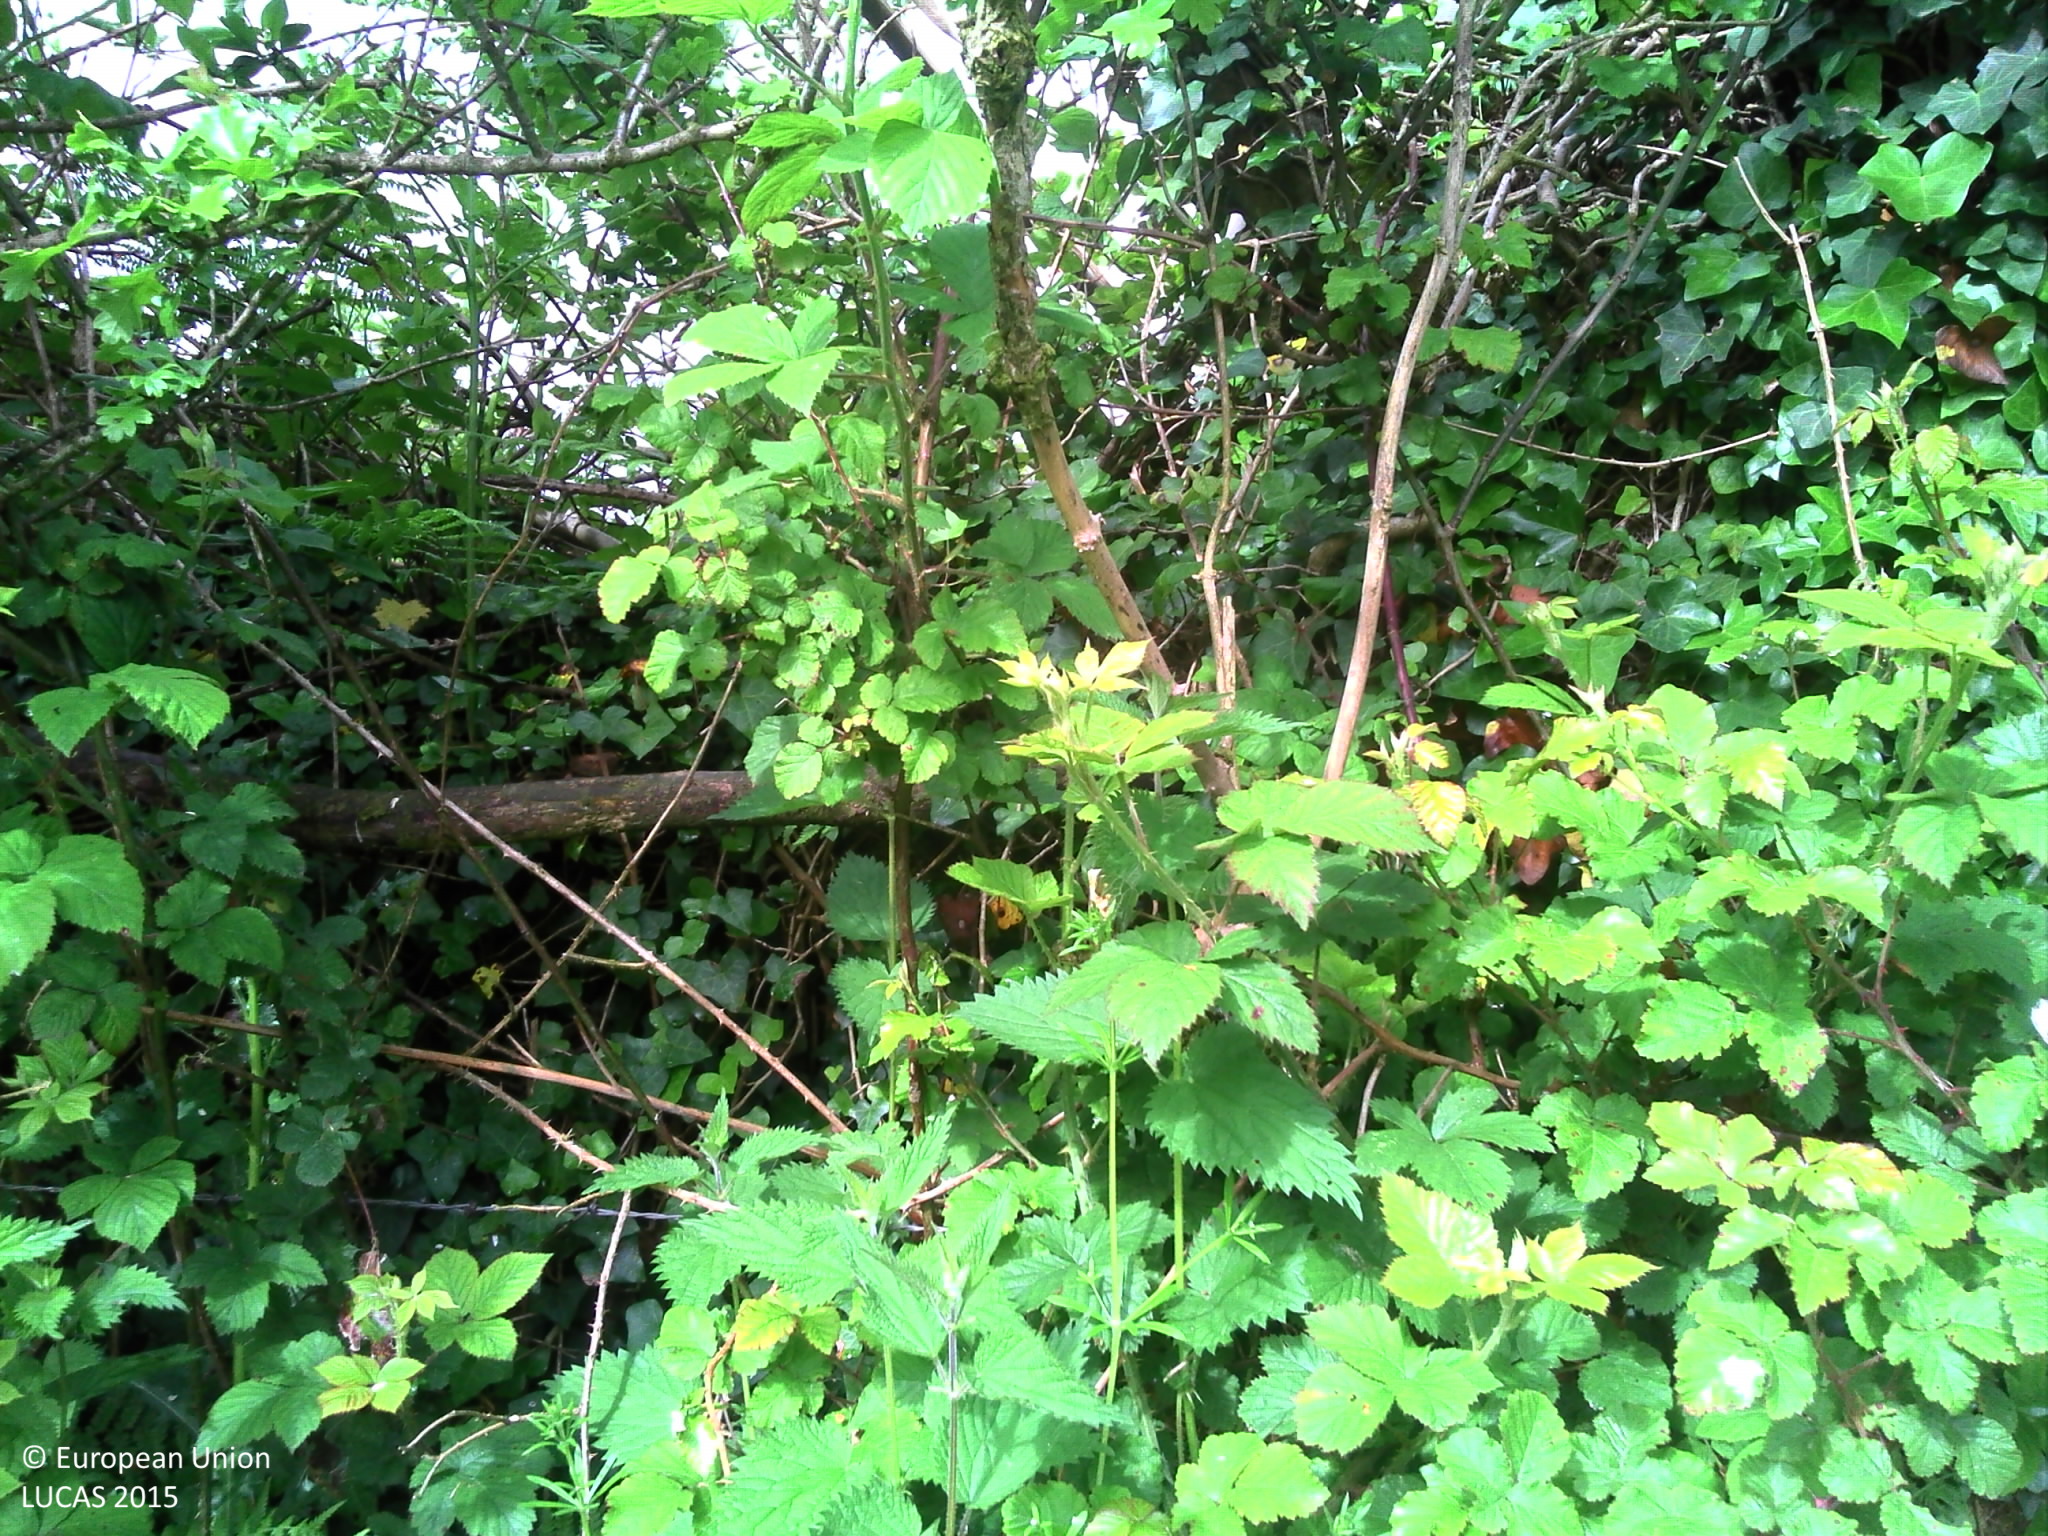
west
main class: Grassland
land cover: Grassland without tree/shrub cover
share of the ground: > 75 %
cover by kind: herbaceous plants 100 %
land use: Agriculture (excluding fallow land and kitchen gardens)
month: June
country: FR
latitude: 49.5519
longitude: -1.7890
